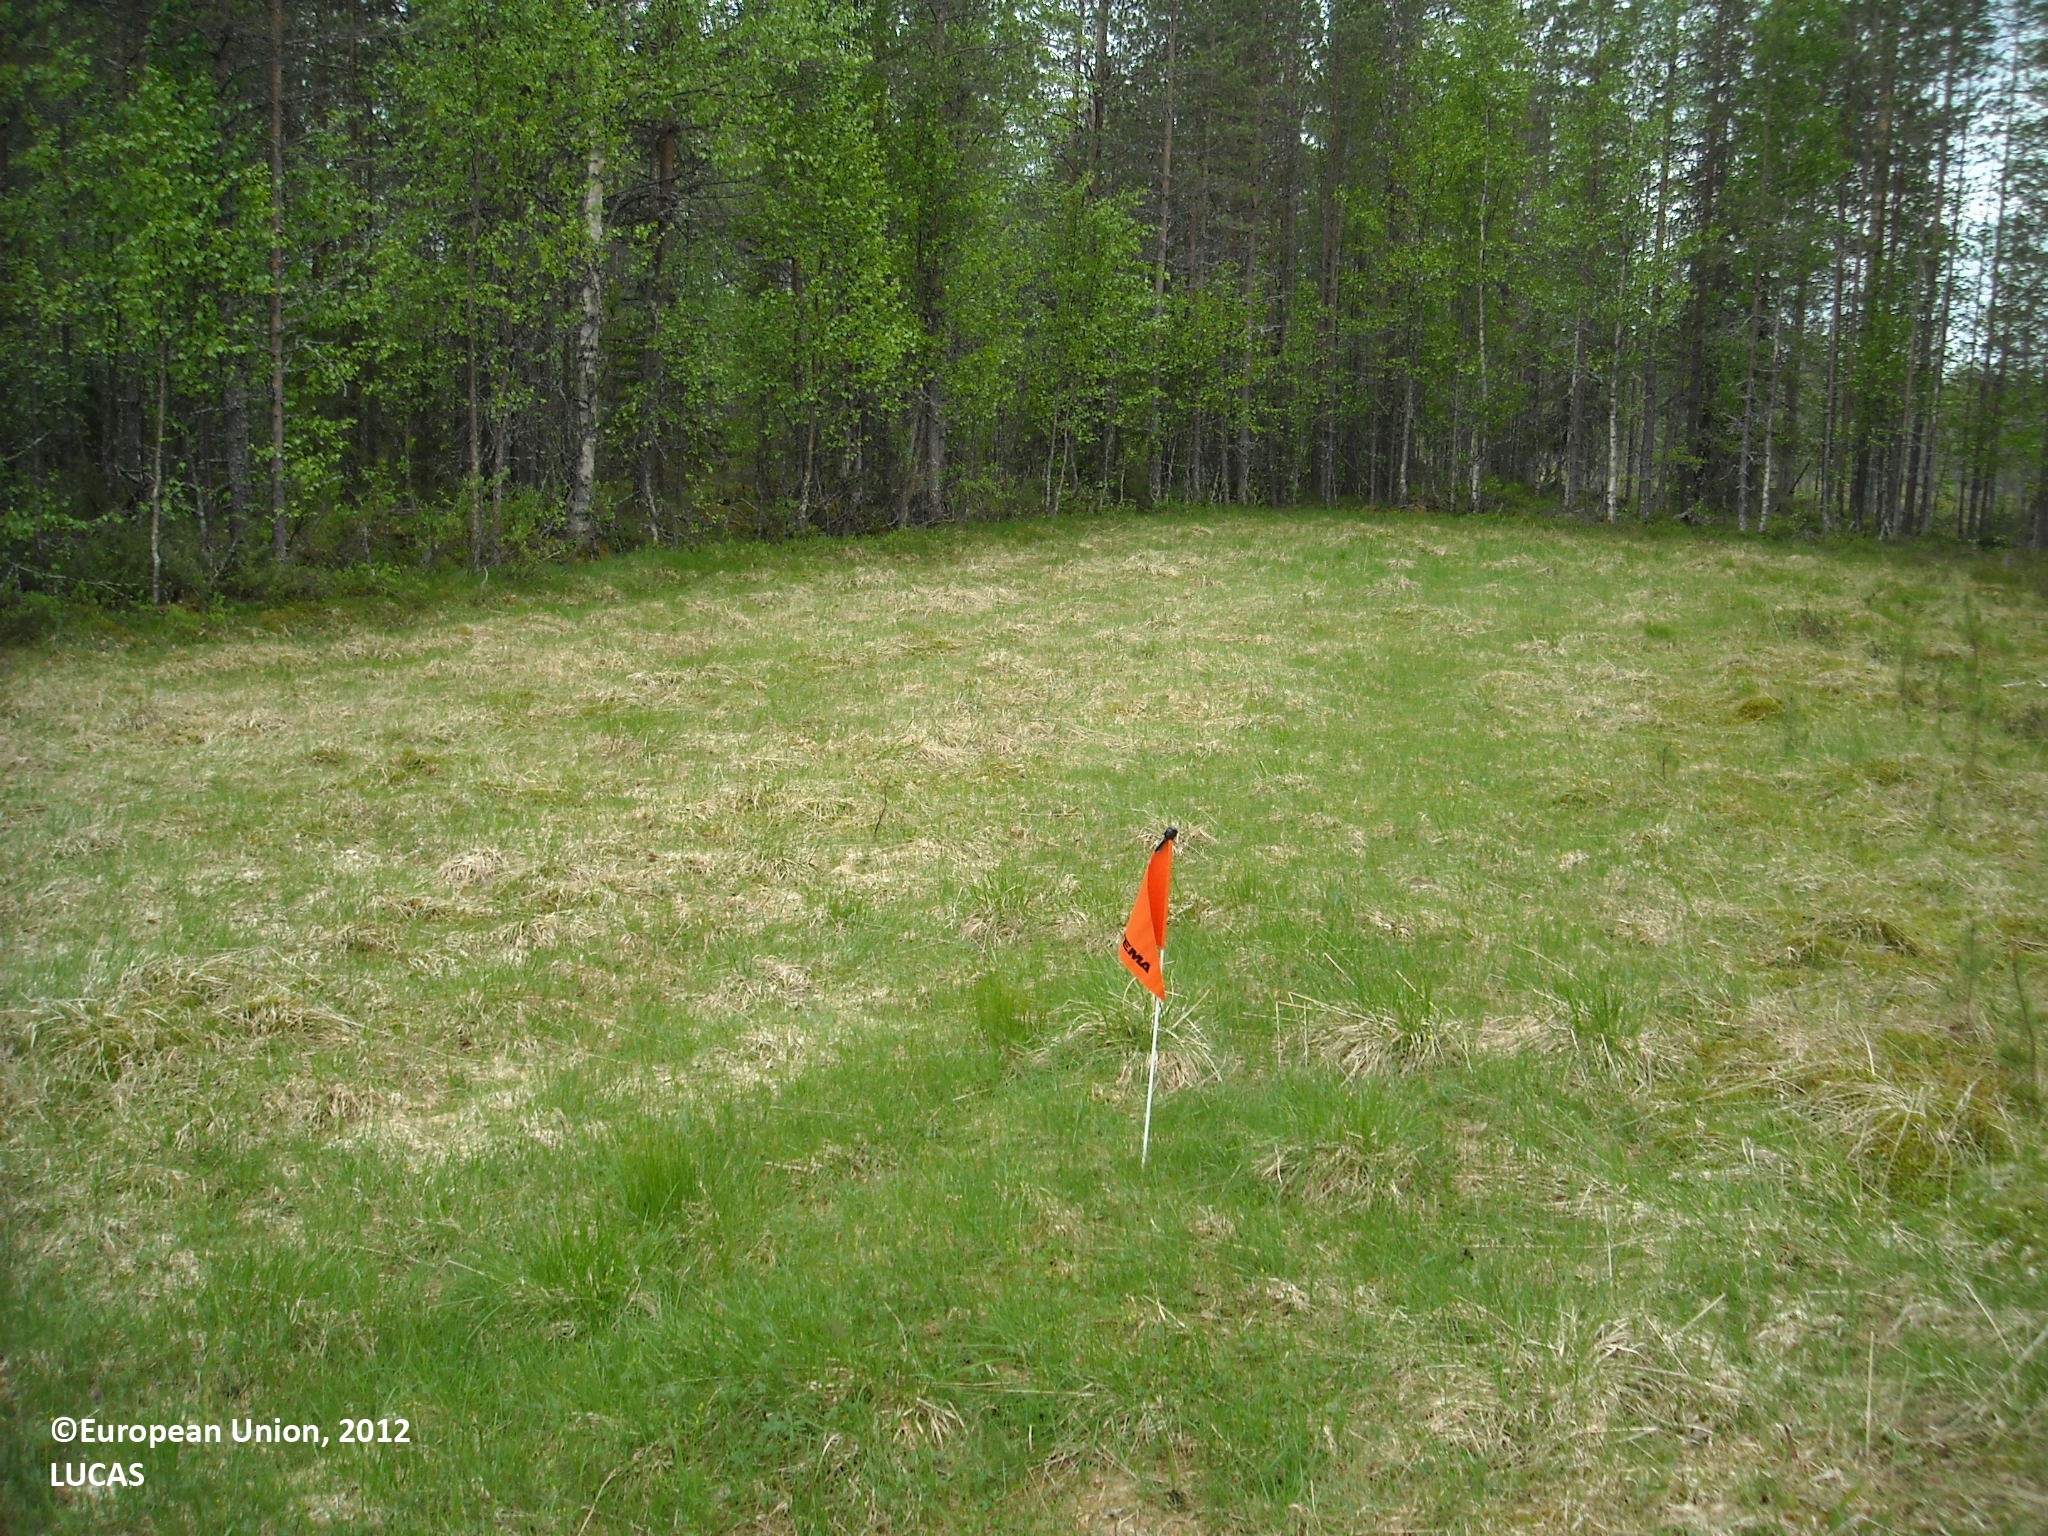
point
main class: Grassland
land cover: Grassland without tree/shrub cover
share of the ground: > 75 %
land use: Agriculture (excluding fallow land and kitchen gardens)
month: June
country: FI
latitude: 65.5596
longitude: 27.9697
